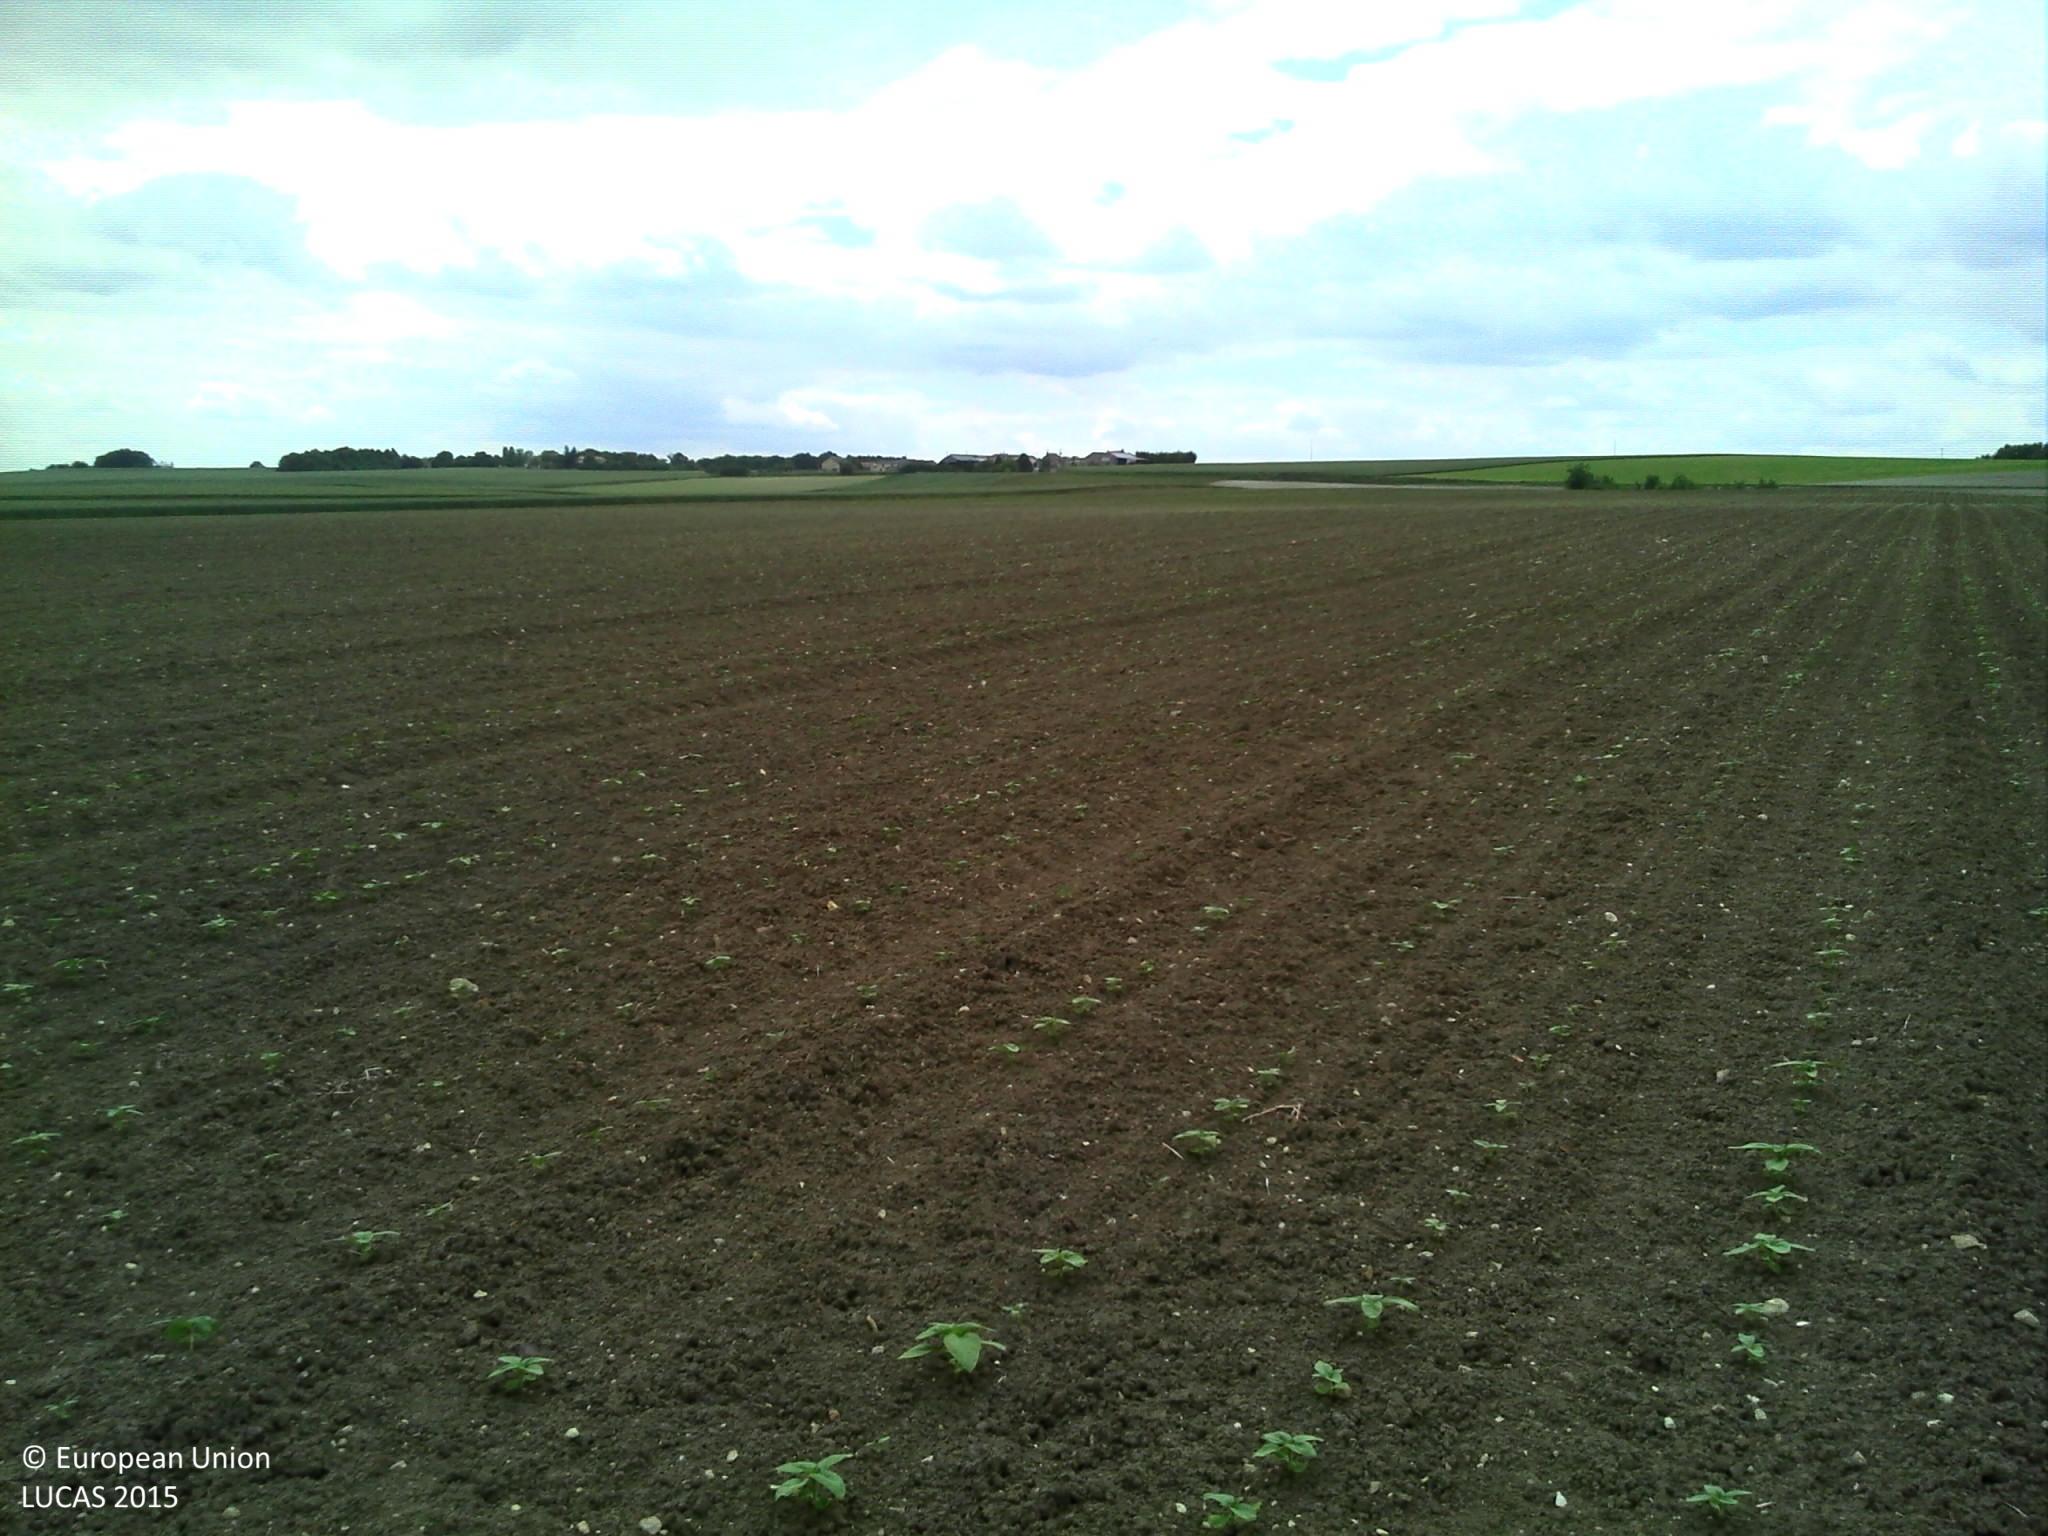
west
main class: Cropland
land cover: Sunflower
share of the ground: 10 - 25 %
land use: Agriculture (excluding fallow land and kitchen gardens)
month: May
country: FR
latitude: 46.7929
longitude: 0.2454
